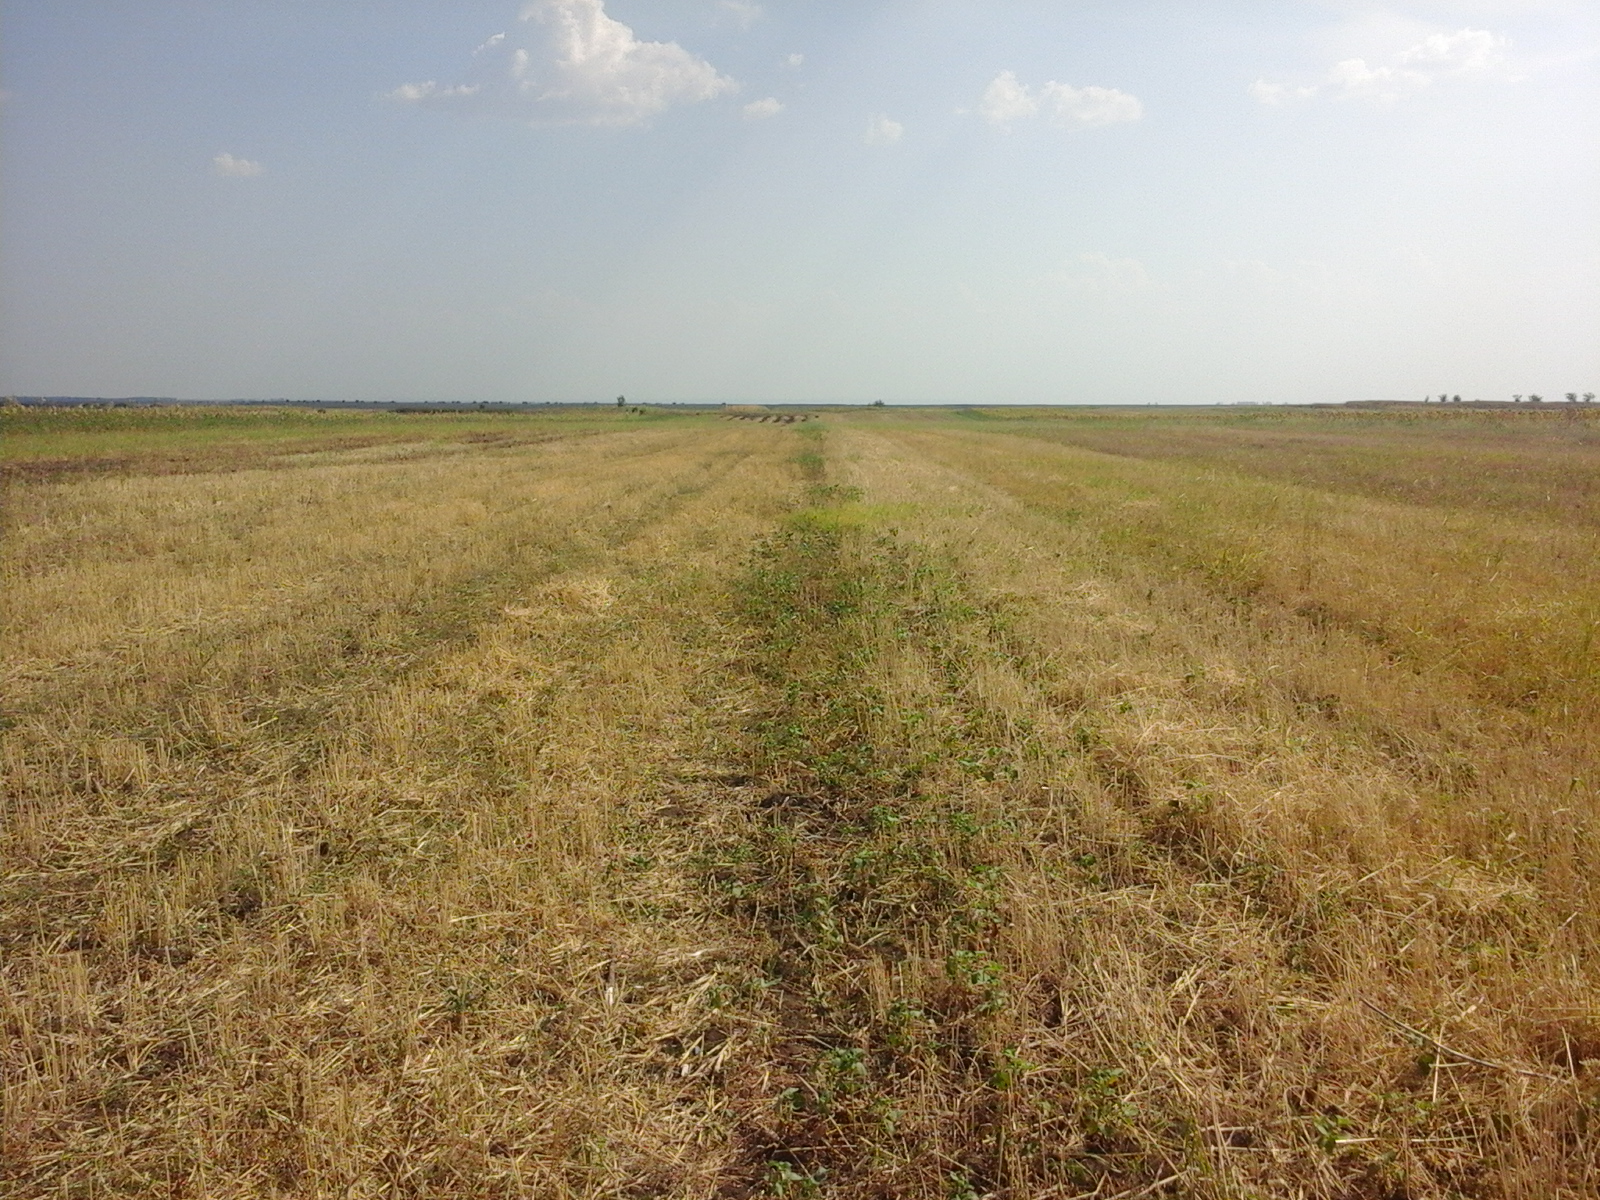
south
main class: Cropland
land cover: Common wheat
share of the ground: > 75 %
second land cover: Spontaneously vegetated surfaces
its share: 25 - 50 %
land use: Agriculture (excluding fallow land and kitchen gardens)
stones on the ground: < 10 %
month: August
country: RO
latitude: 44.0960
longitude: 23.5536
